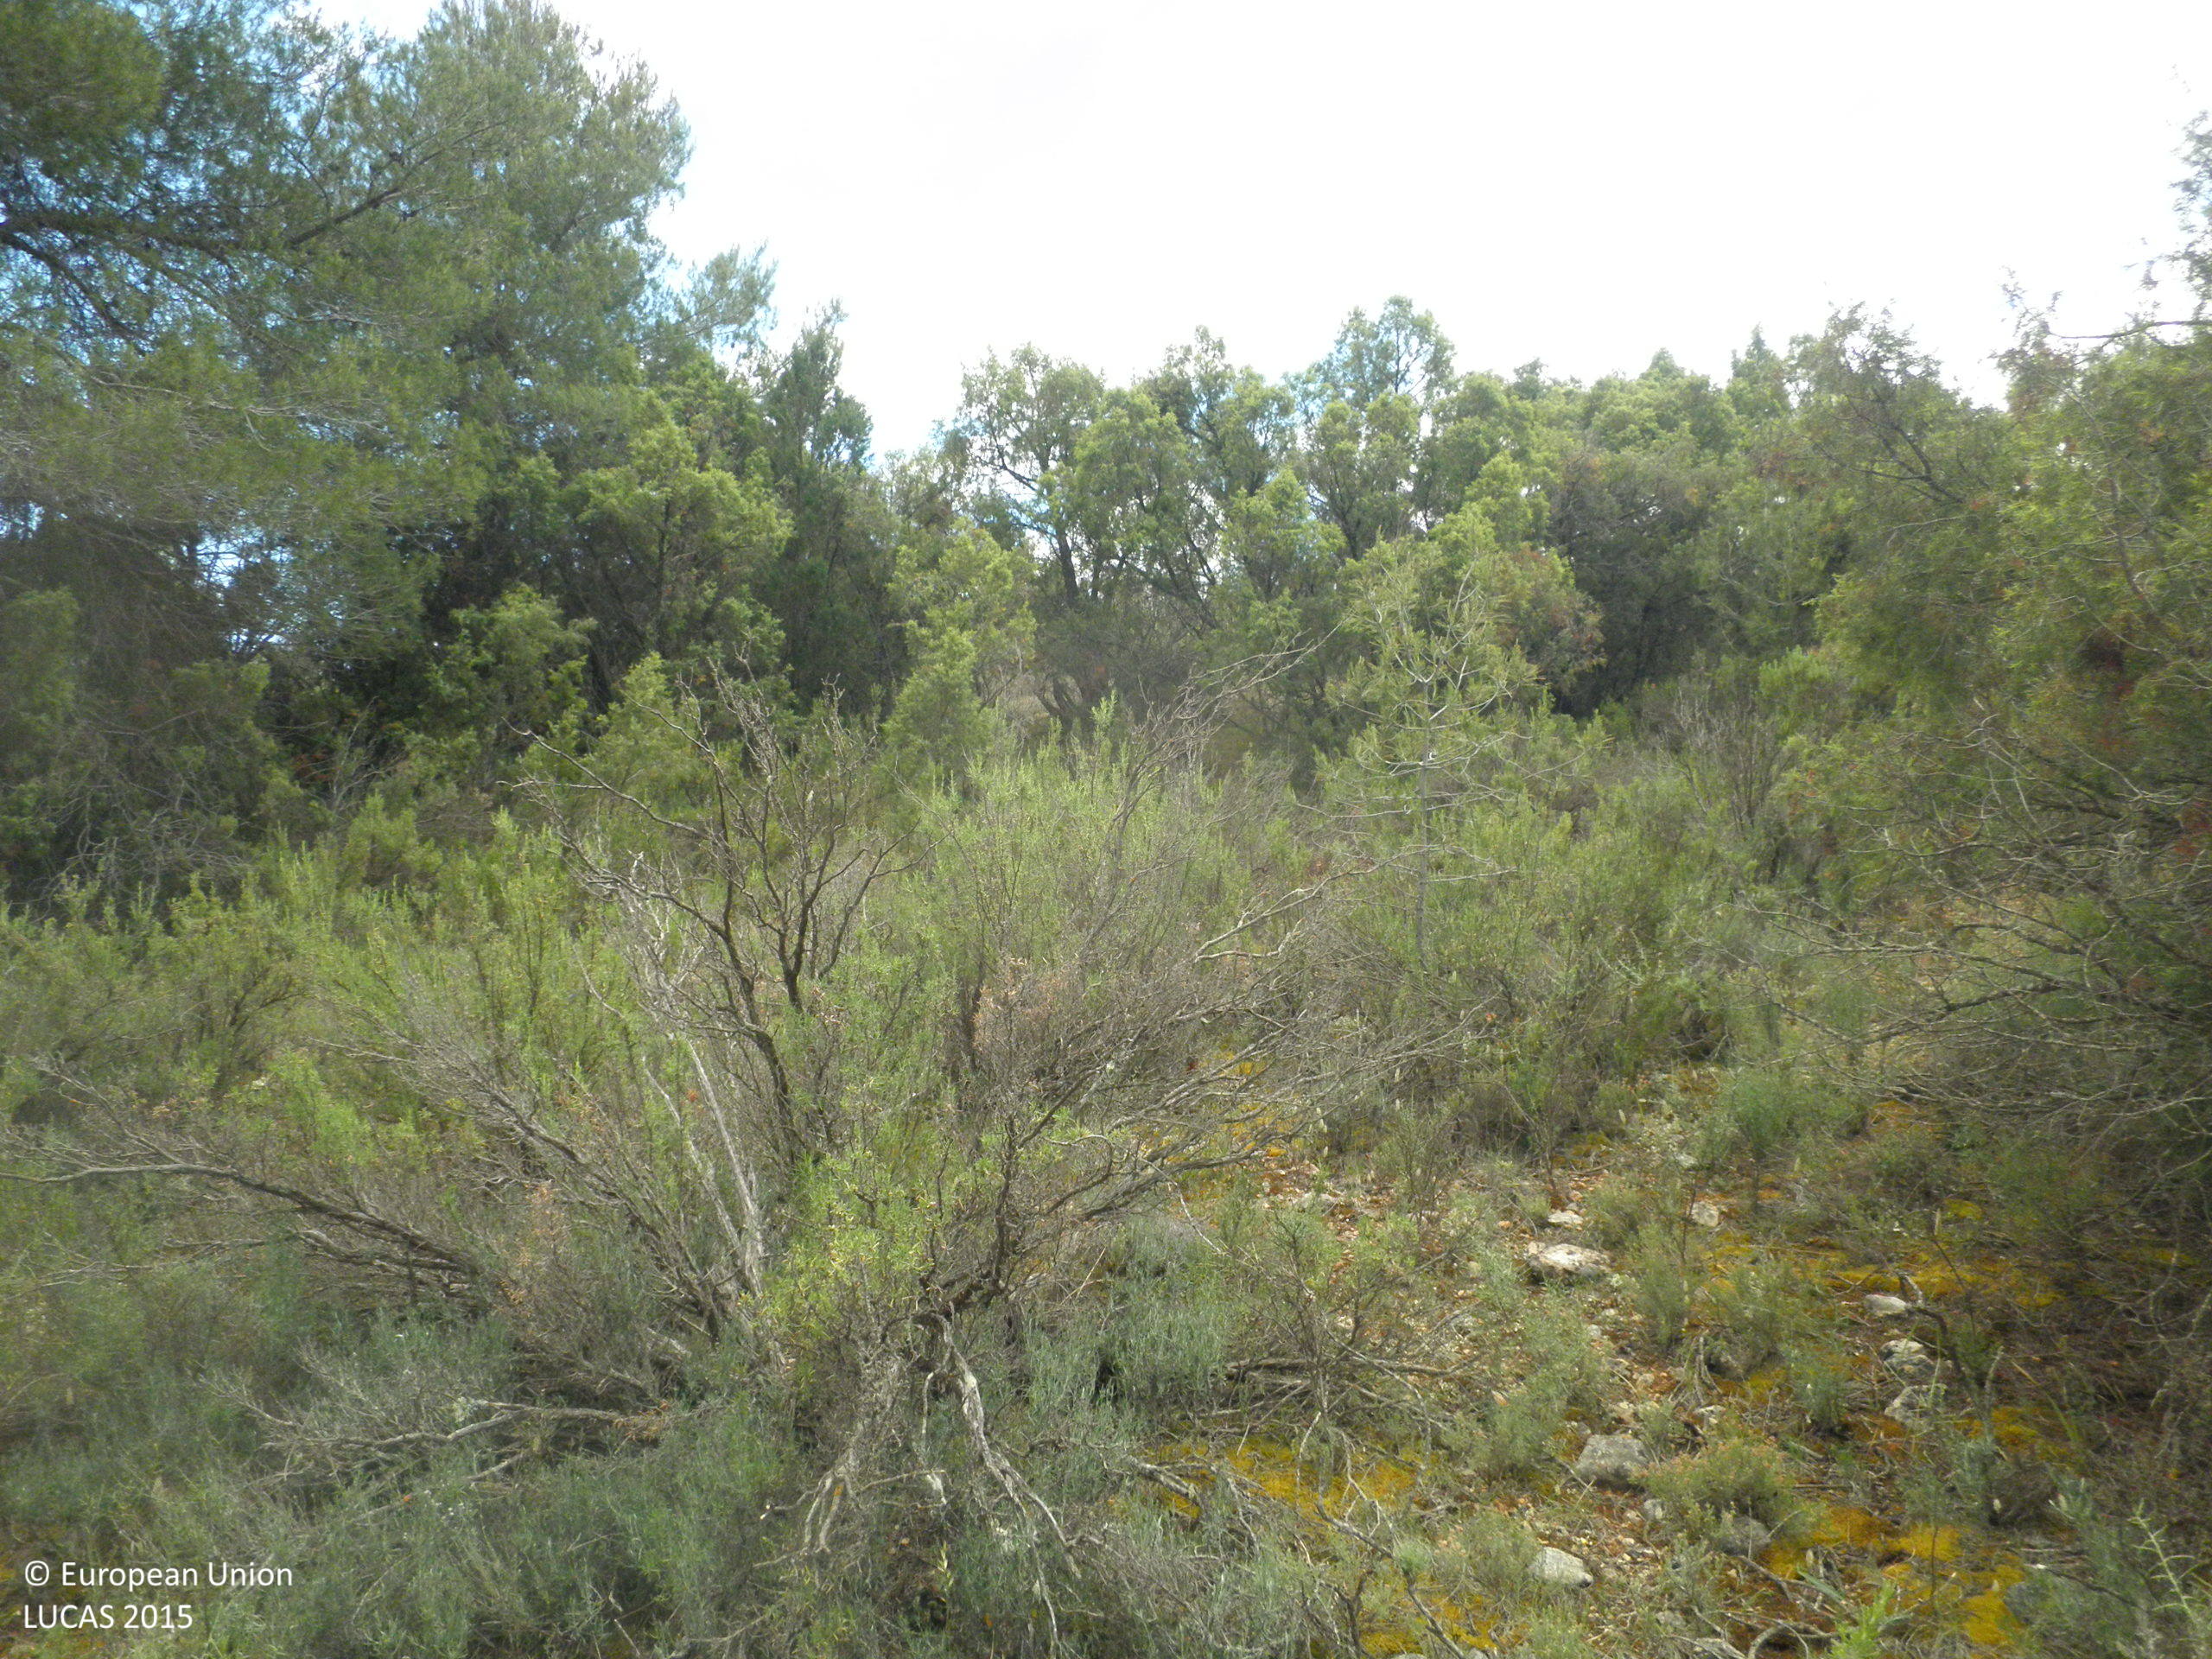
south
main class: Woodland
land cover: Pine dominated coniferous woodland
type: coniferous forest of the mediterranean region
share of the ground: 10 - 25 %
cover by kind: shrubs 75 %, coniferous forest trees 15 %, unconsolidated bare surface 10 %
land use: Semi-natural and natural areas not in use
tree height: > 5 m
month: June
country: ES
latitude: 39.7390
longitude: -1.6183
